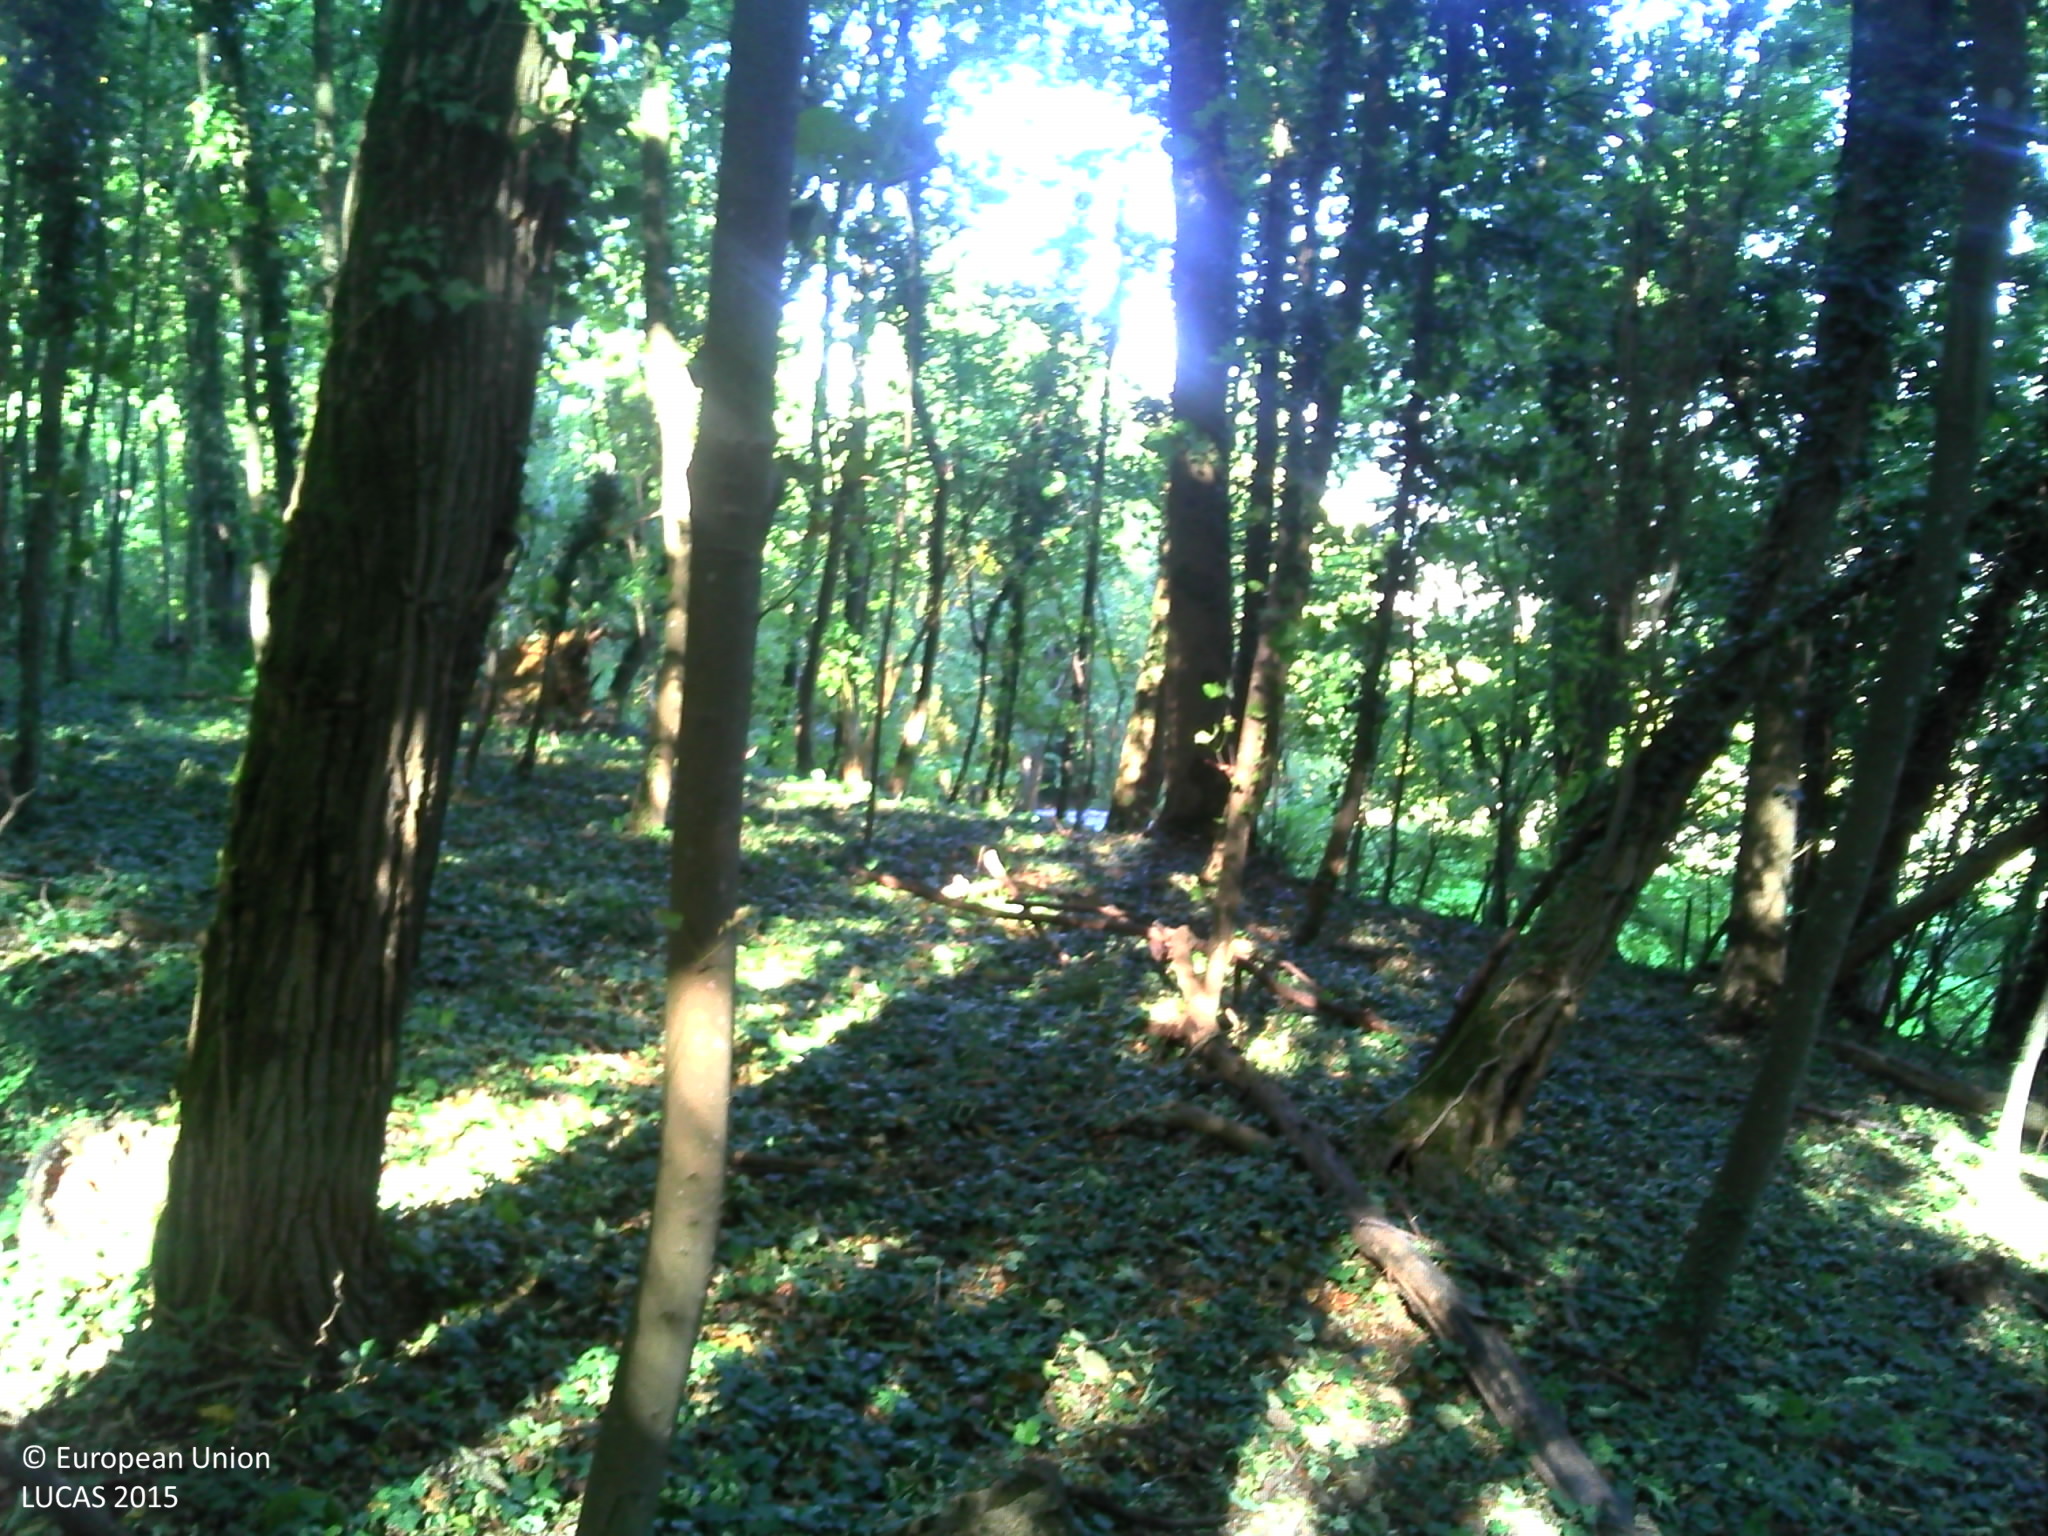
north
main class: Woodland
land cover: Broadleaved woodland
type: mesophytic deciduous forest
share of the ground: > 75 %
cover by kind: broadleaved forest trees 90 %, herbaceous plants 5 %, consolidated bare surface 5 %
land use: Forestry
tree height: > 5 m
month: October
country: FR
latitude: 48.9086
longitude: 6.0293
